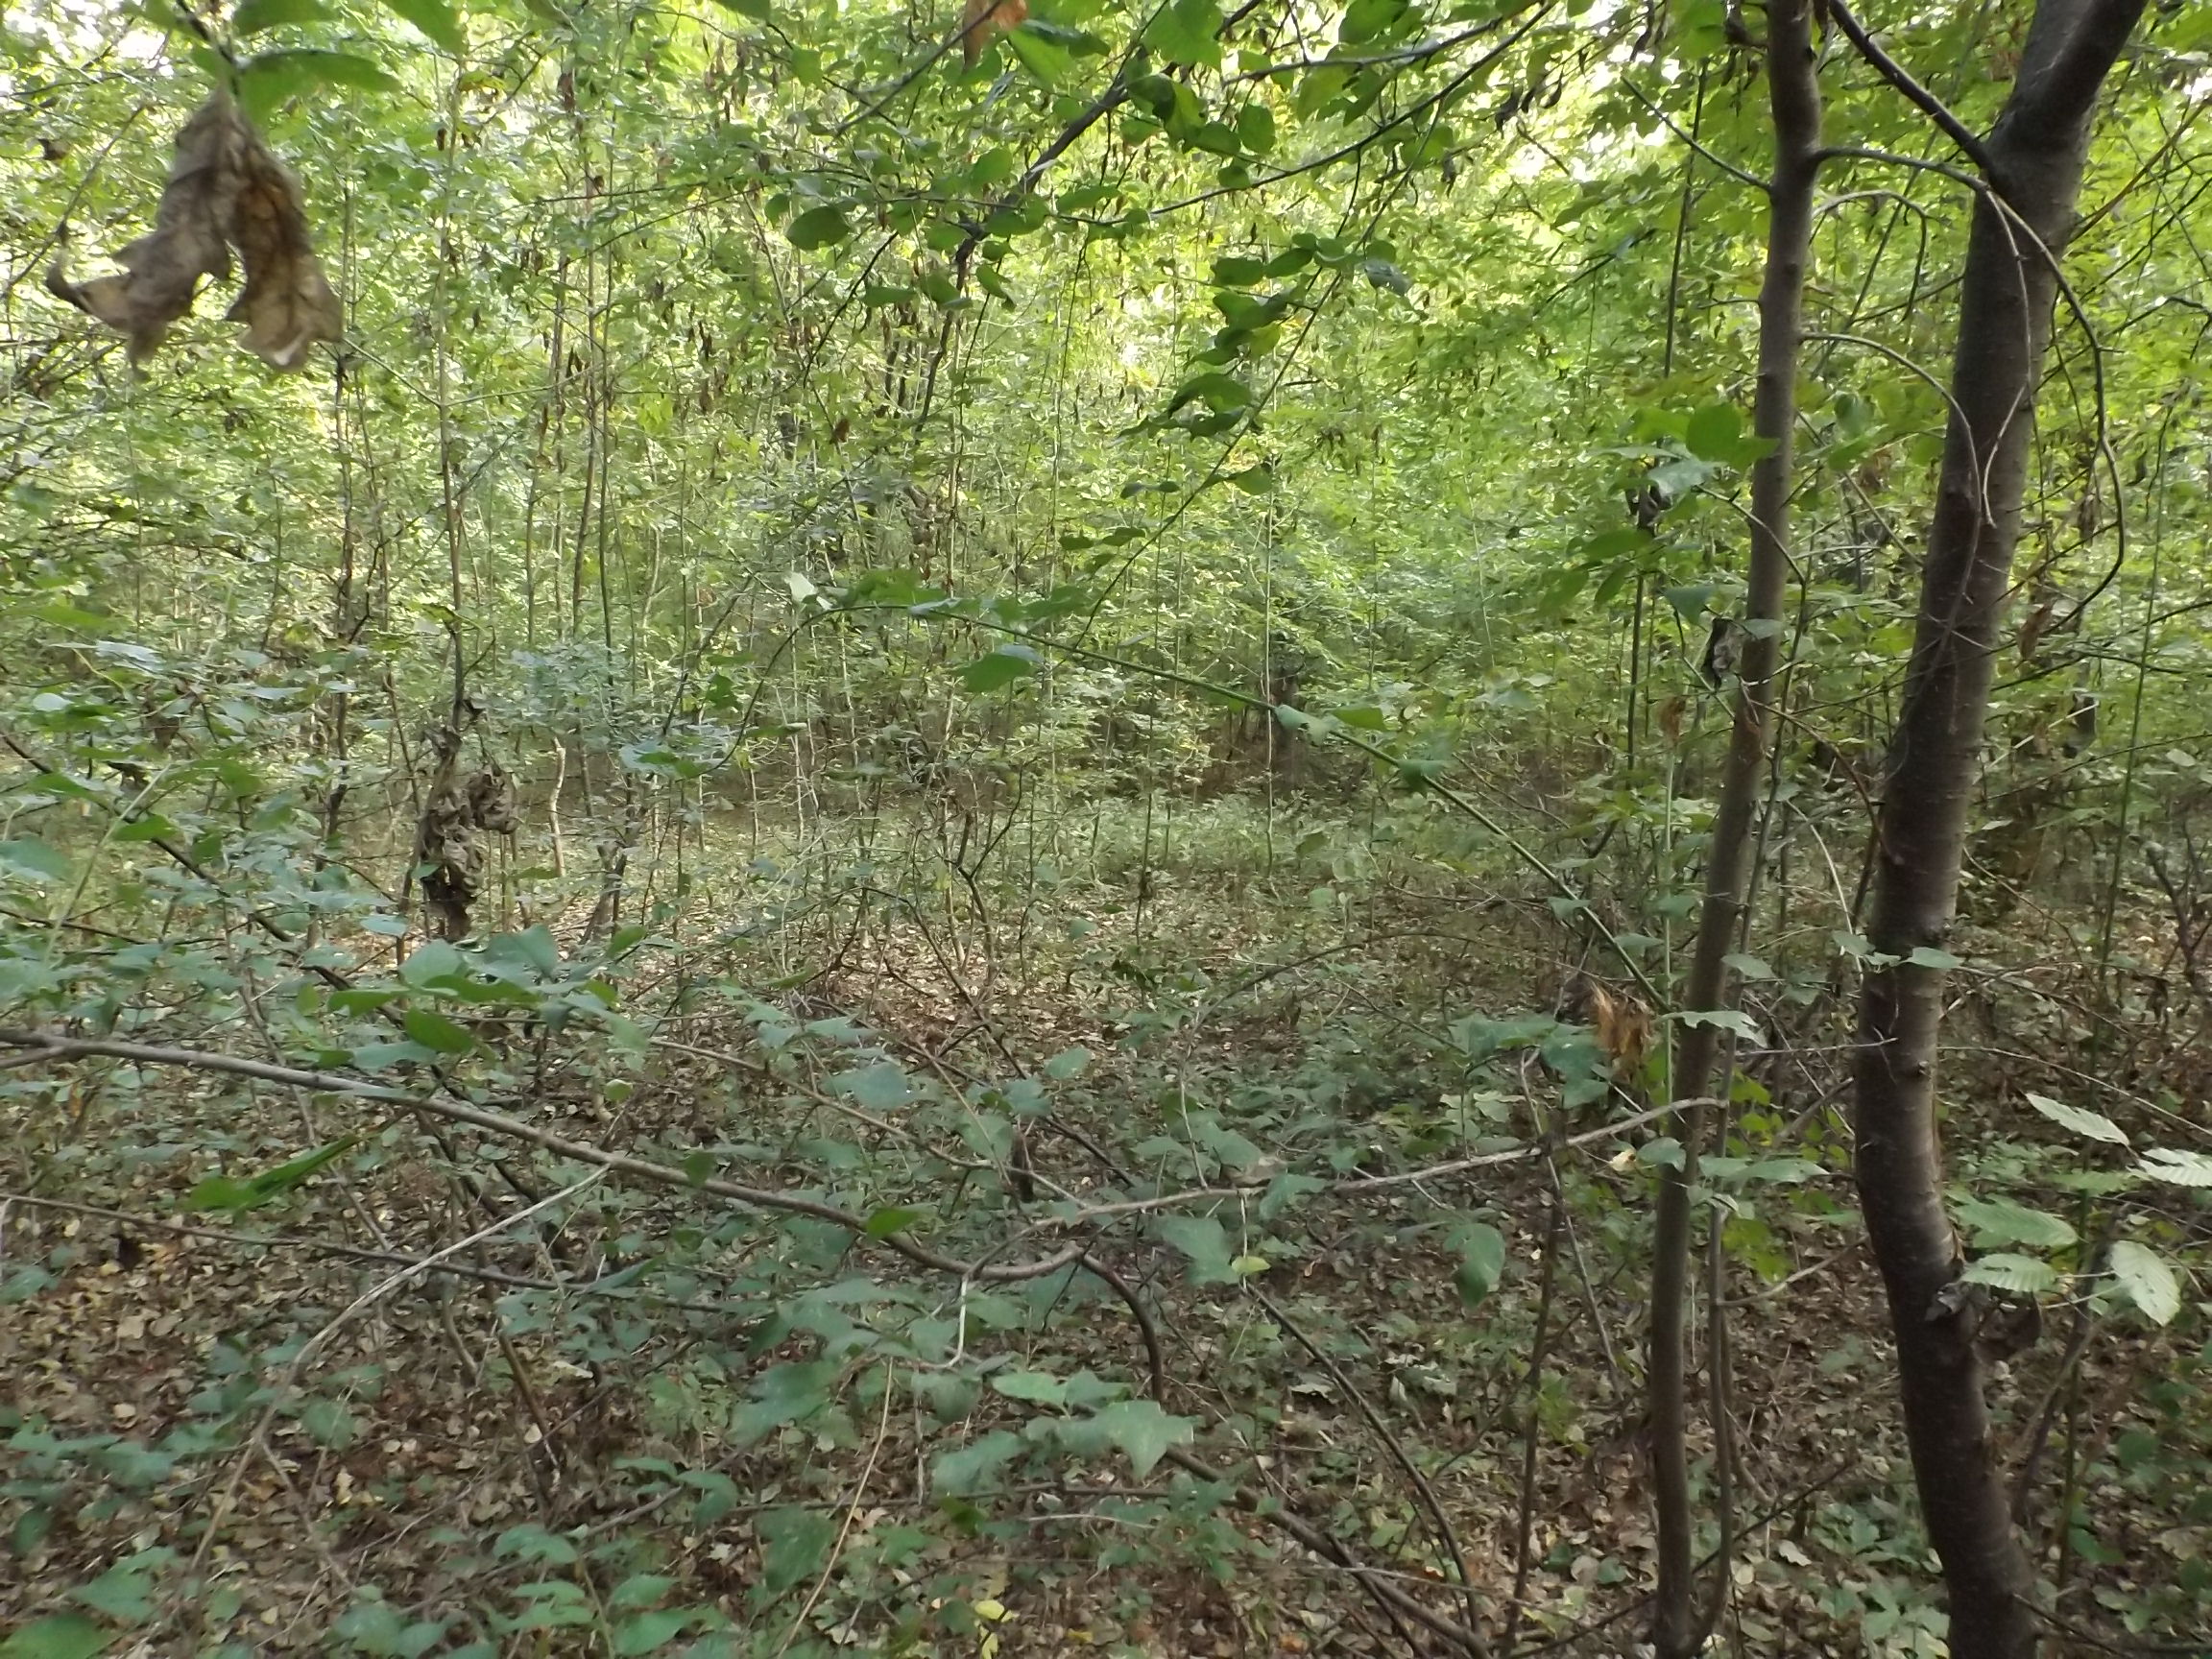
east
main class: Woodland
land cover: Broadleaved woodland
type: beech forest
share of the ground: > 75 %
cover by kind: broadleaved forest trees 100 %
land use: Forestry
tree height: > 5 m
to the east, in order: Broadleaved woodland
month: October
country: BG
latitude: 43.8655
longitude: 26.8279
